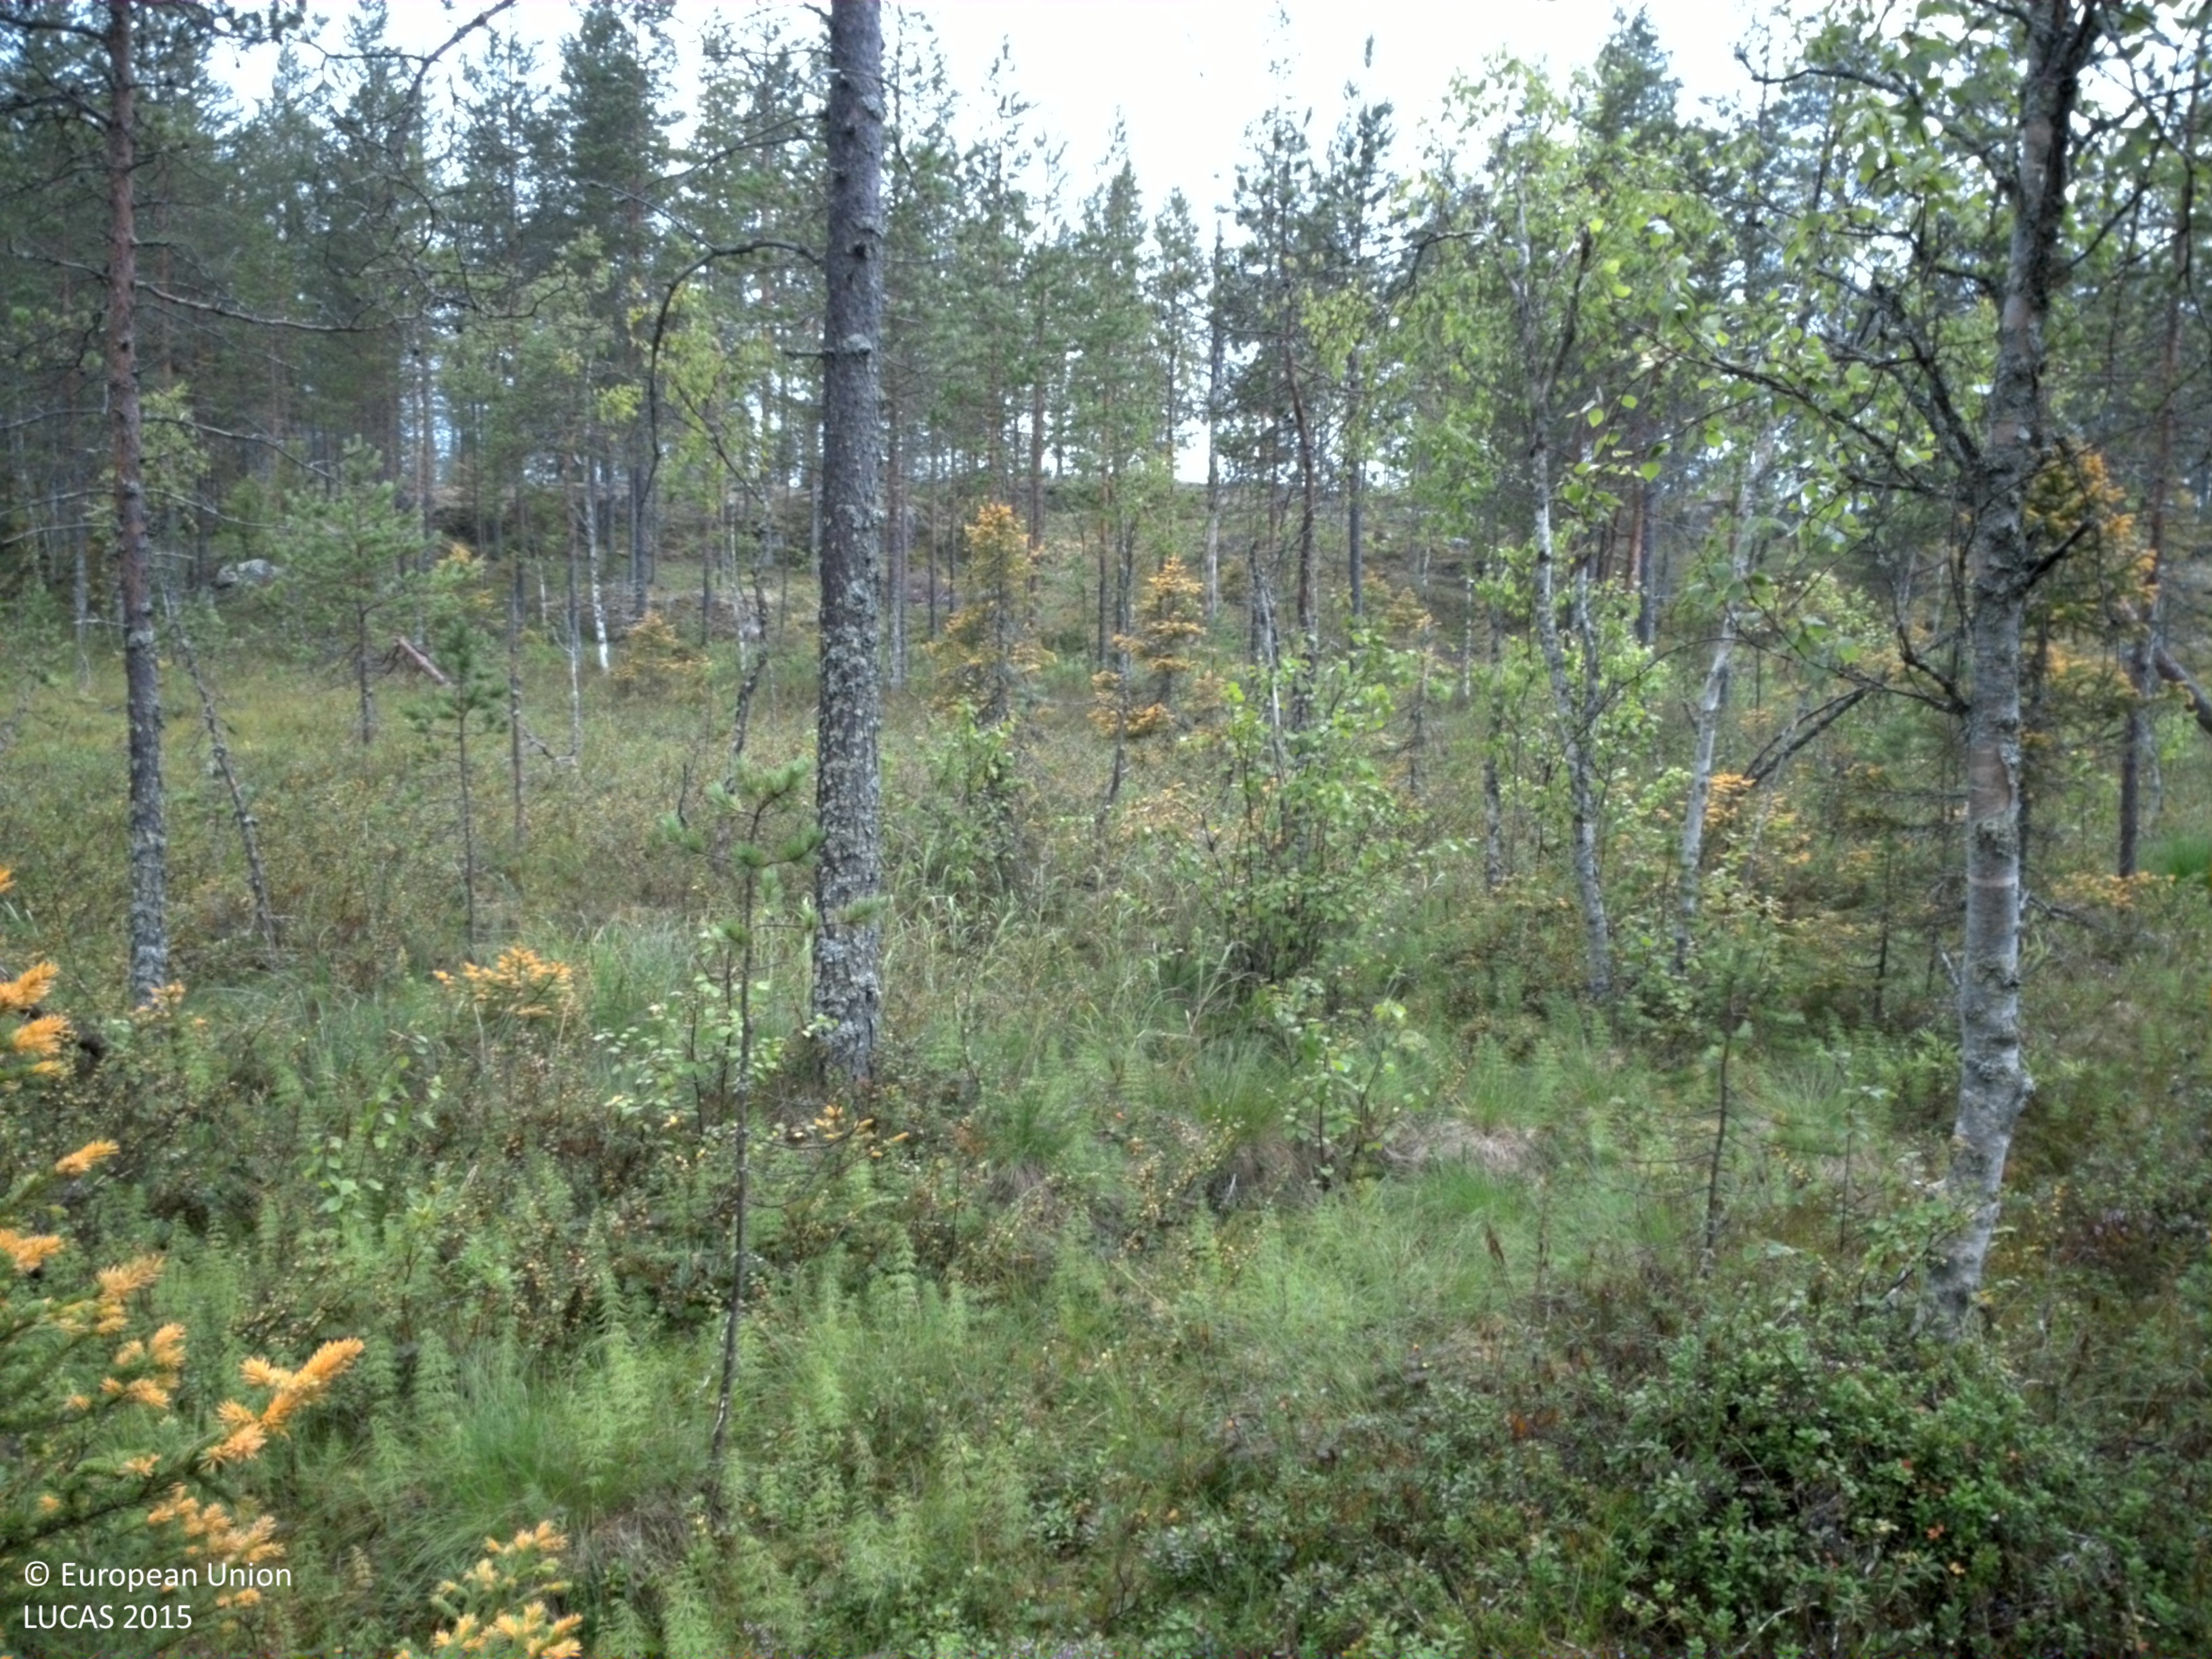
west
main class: Woodland
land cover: Pine dominated coniferous woodland
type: boreal forest
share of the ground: 25 - 50 %
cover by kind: shrubs 40 %, lichens and mosses 30 %, coniferous forest trees 25 %, consolidated bare surface 5 %
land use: Forestry
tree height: > 5 m
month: August
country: SE
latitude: 65.9620
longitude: 22.6750
